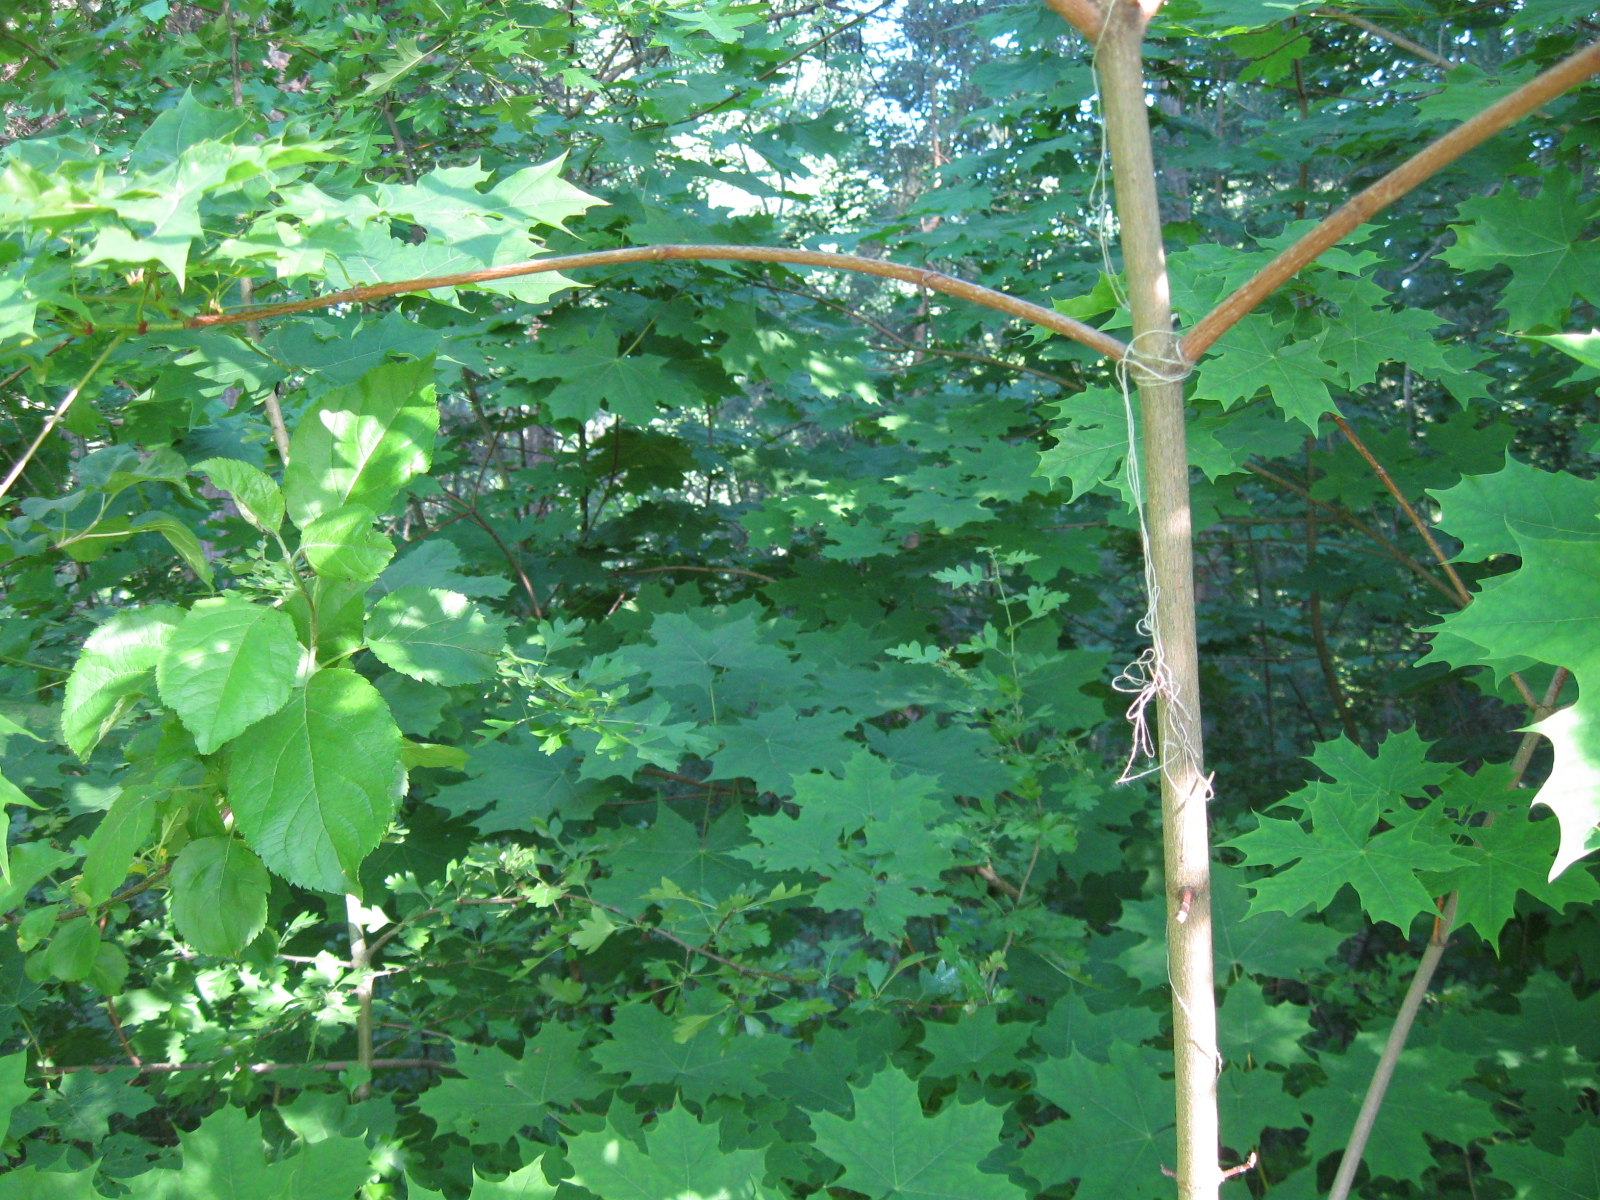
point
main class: Woodland
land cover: Pine dominated mixed woodland
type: hemiboreal forest and nemoral coniferous forest and mixed broadleaved-coniferous forest
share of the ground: > 75 %
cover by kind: broadleaved forest trees 60 %, coniferous forest trees 40 %
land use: Community services
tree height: > 5 m
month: June
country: LT
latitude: 54.8871
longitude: 23.9807
